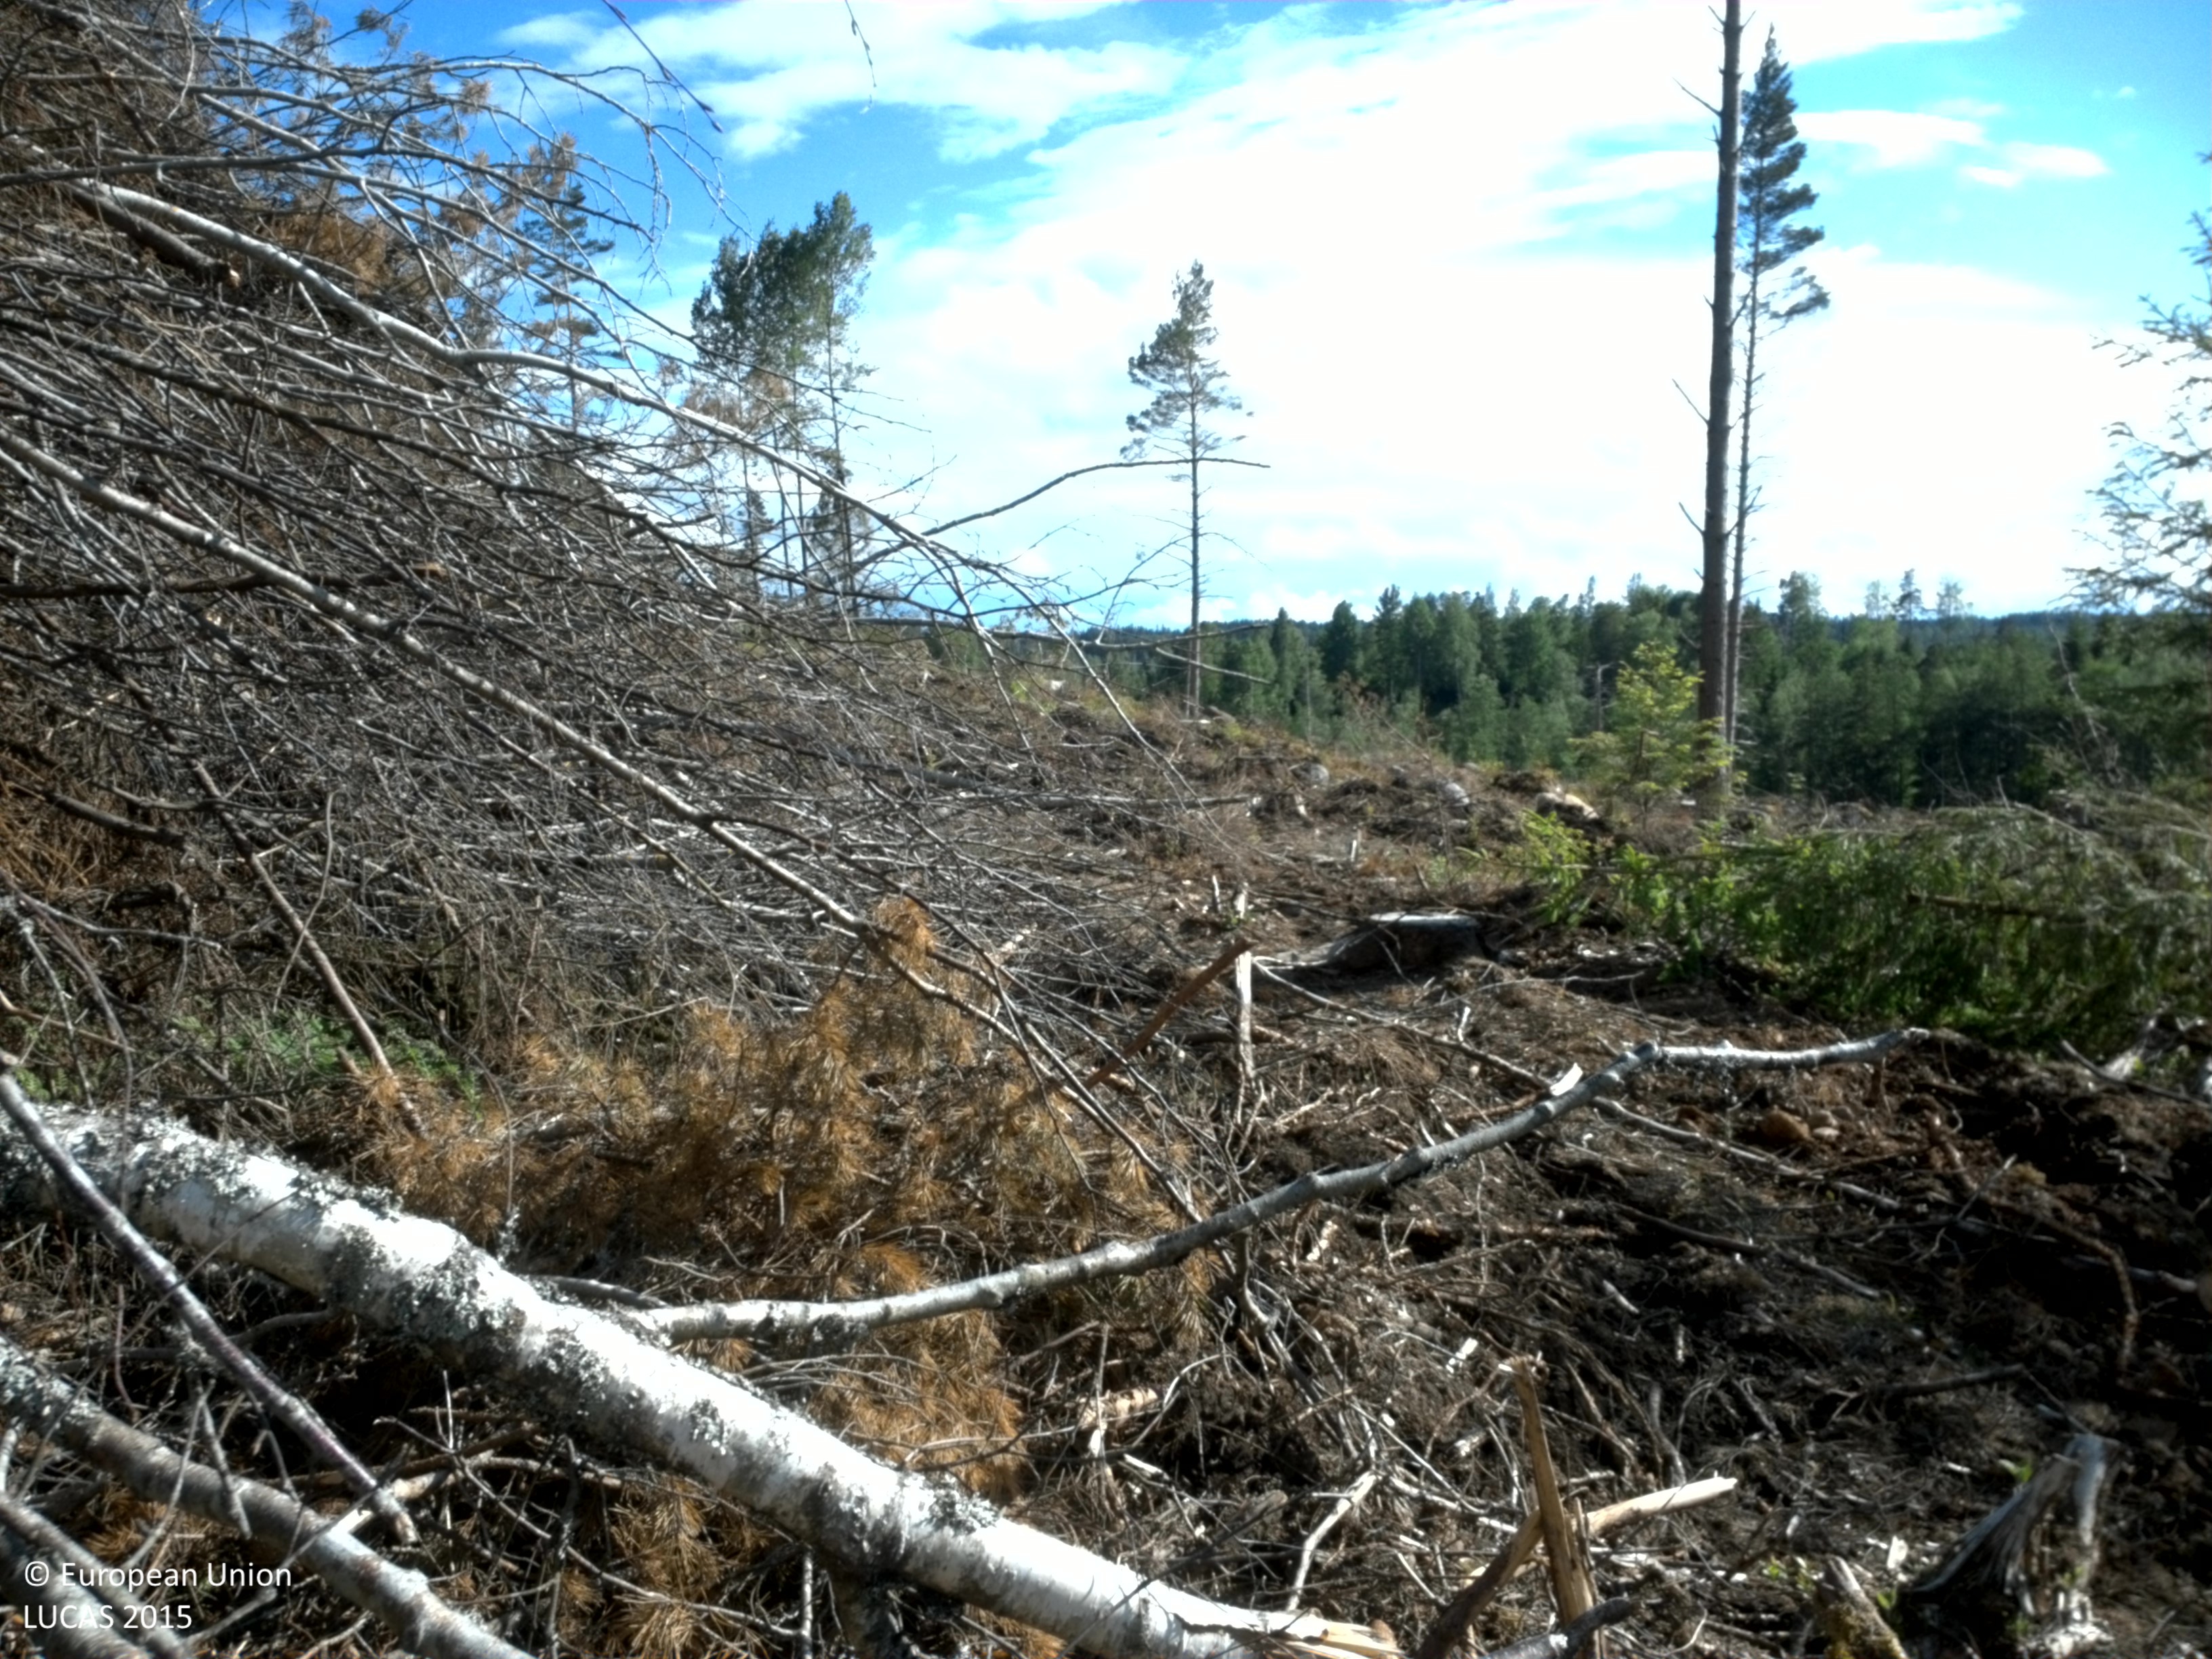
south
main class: Woodland
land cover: Spruce dominated coniferous woodland
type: boreal forest
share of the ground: 10 - 25 %
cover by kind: consolidated bare surface 80 %, coniferous forest trees 10 %, herbaceous plants 10 %
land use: Forestry
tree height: < 5 m
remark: Clear cut
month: June
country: SE
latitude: 58.5725
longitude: 15.5823
